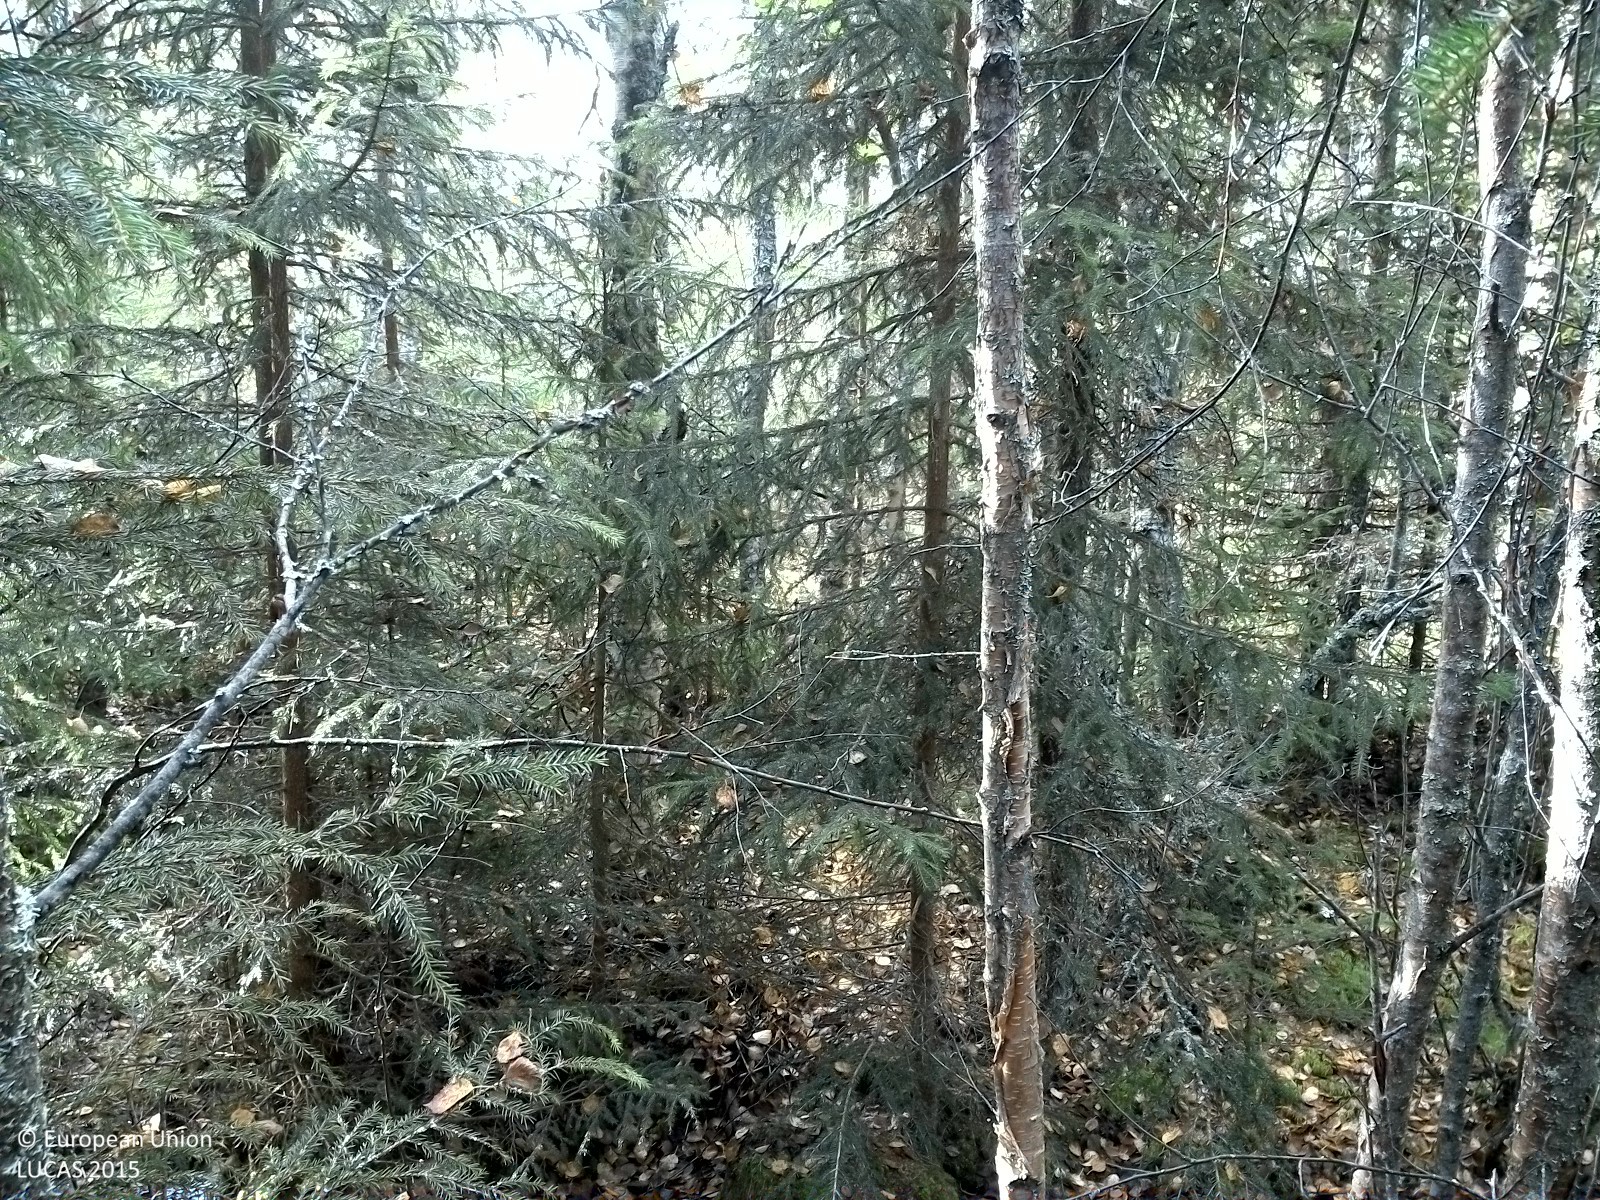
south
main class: Woodland
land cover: Spruce dominated mixed woodland
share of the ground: > 75 %
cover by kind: coniferous forest trees 55 %, broadleaved forest trees 30 %, herbaceous plants 10 %, lichens and mosses 5 %
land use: Forestry
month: September
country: SE
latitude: 62.1762
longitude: 16.2223
